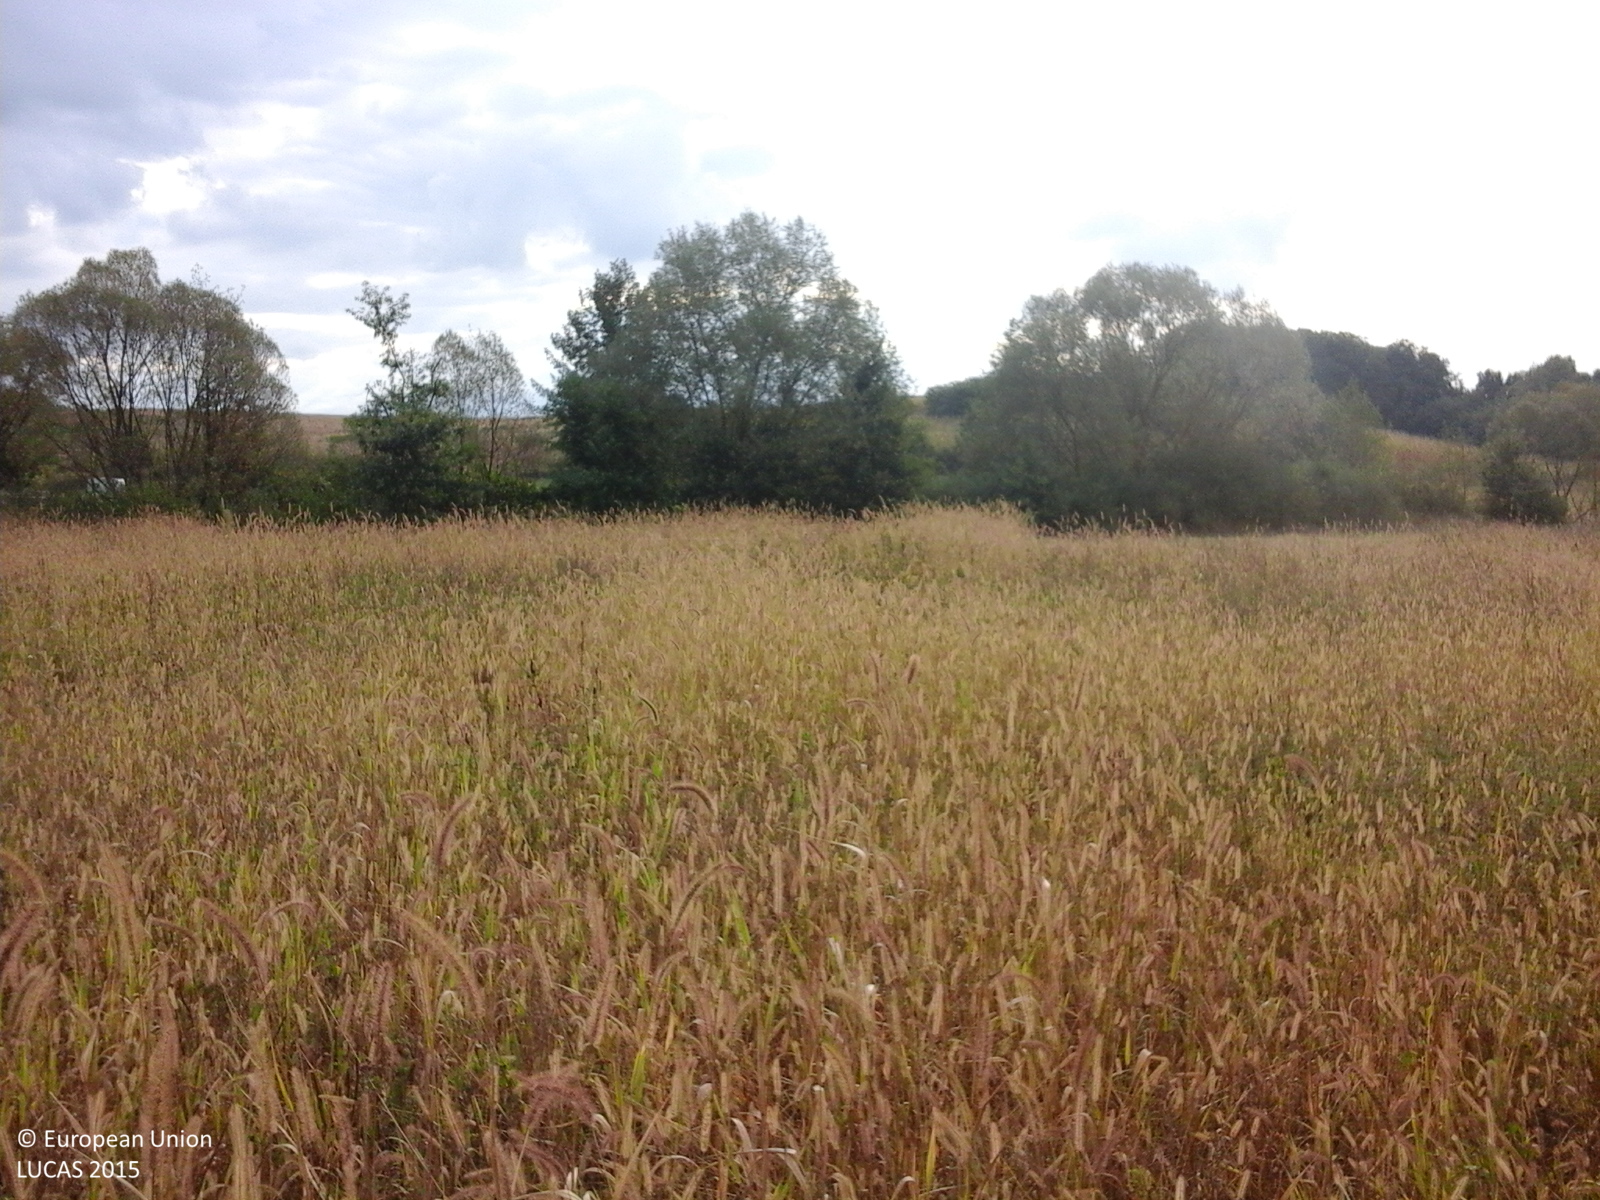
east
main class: Grassland
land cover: Grassland without tree/shrub cover
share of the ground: > 75 %
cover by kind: herbaceous plants 100 %
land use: Agriculture (excluding fallow land and kitchen gardens)
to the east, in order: Grassland without tree/shrub cover; Tracks; Abandoned hedges; Ditches and canals; Abandoned hedges; Grassland without tree/shrub cover; Tracks; Abandoned hedges; Maize
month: September
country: RO
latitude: 47.5934
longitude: 23.4656
